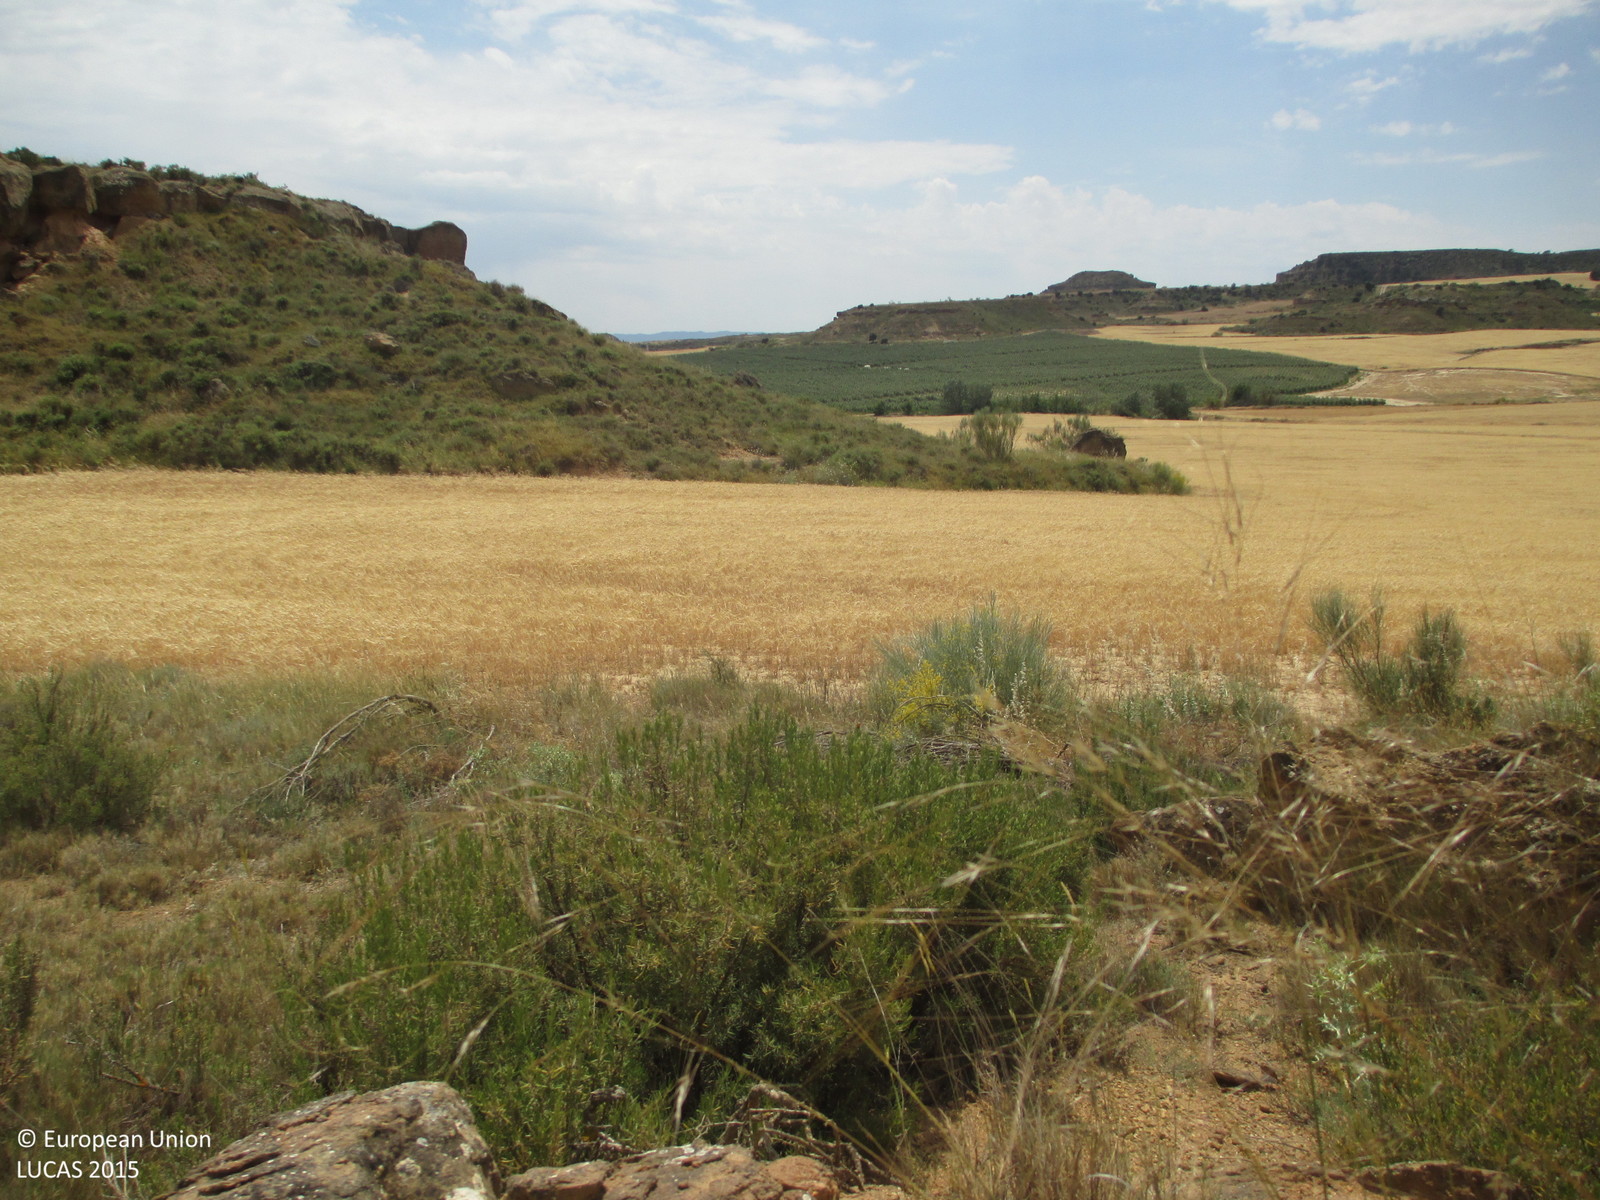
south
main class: Shrubland
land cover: Shrubland without tree cover
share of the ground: > 75 %
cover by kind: shrubs 90 %, herbaceous plants 10 %
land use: Semi-natural and natural areas not in use
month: May
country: ES
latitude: 41.9341
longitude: -0.2348
